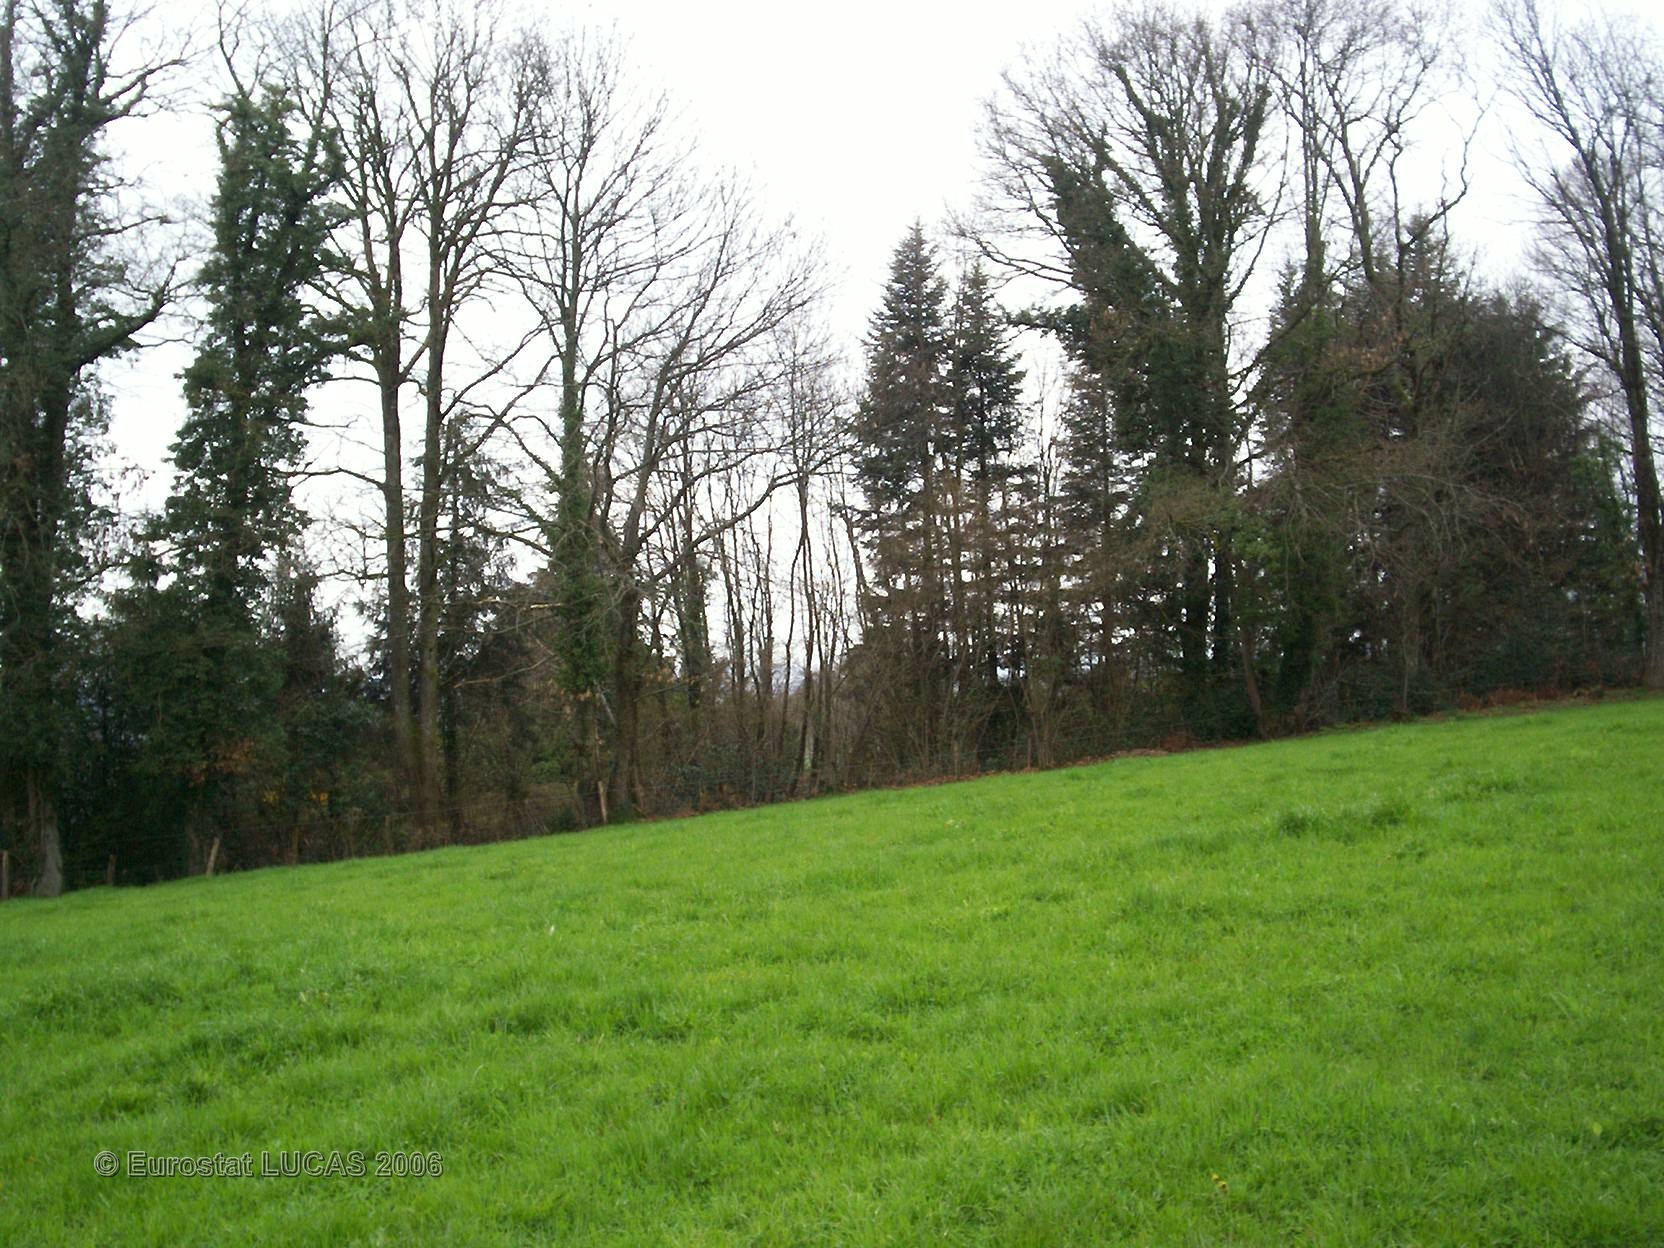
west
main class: Grassland
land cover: Grassland without tree/shrub cover
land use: Agriculture (excluding fallow land and kitchen gardens)
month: April
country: FR
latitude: 45.4962
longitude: 1.6124
